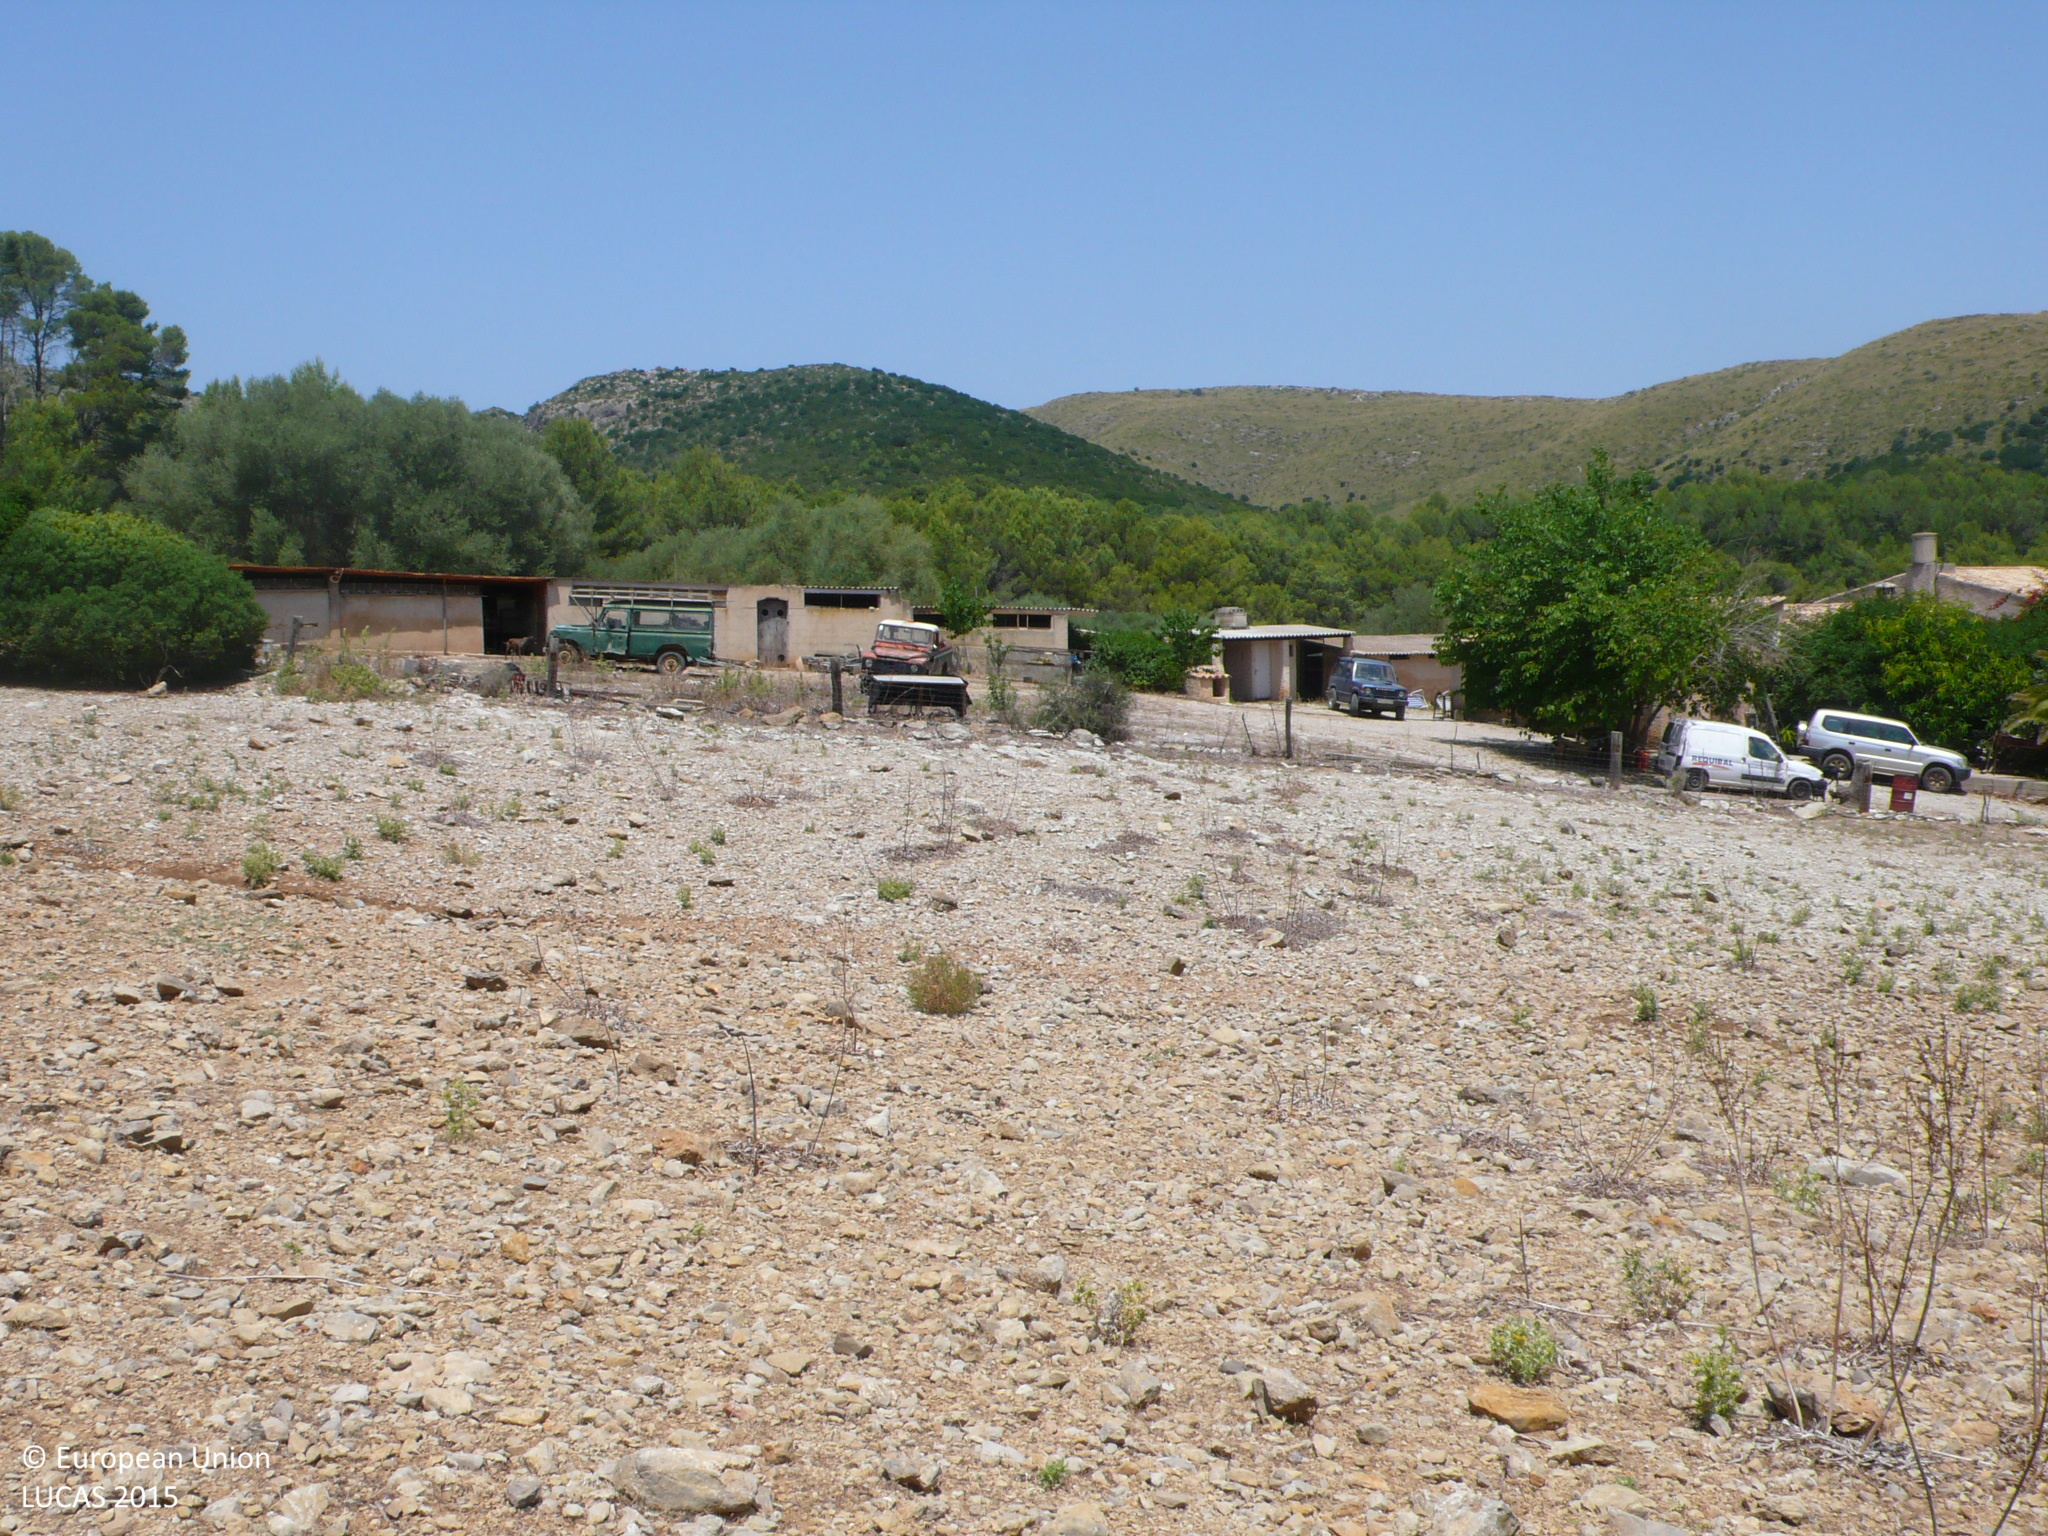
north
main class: Grassland
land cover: Grassland without tree/shrub cover
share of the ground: 25 - 50 %
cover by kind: unconsolidated bare surface 70 %, herbaceous plants 30 %
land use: Agriculture (excluding fallow land and kitchen gardens)
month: July
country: ES
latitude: 39.7127
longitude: 3.3218
